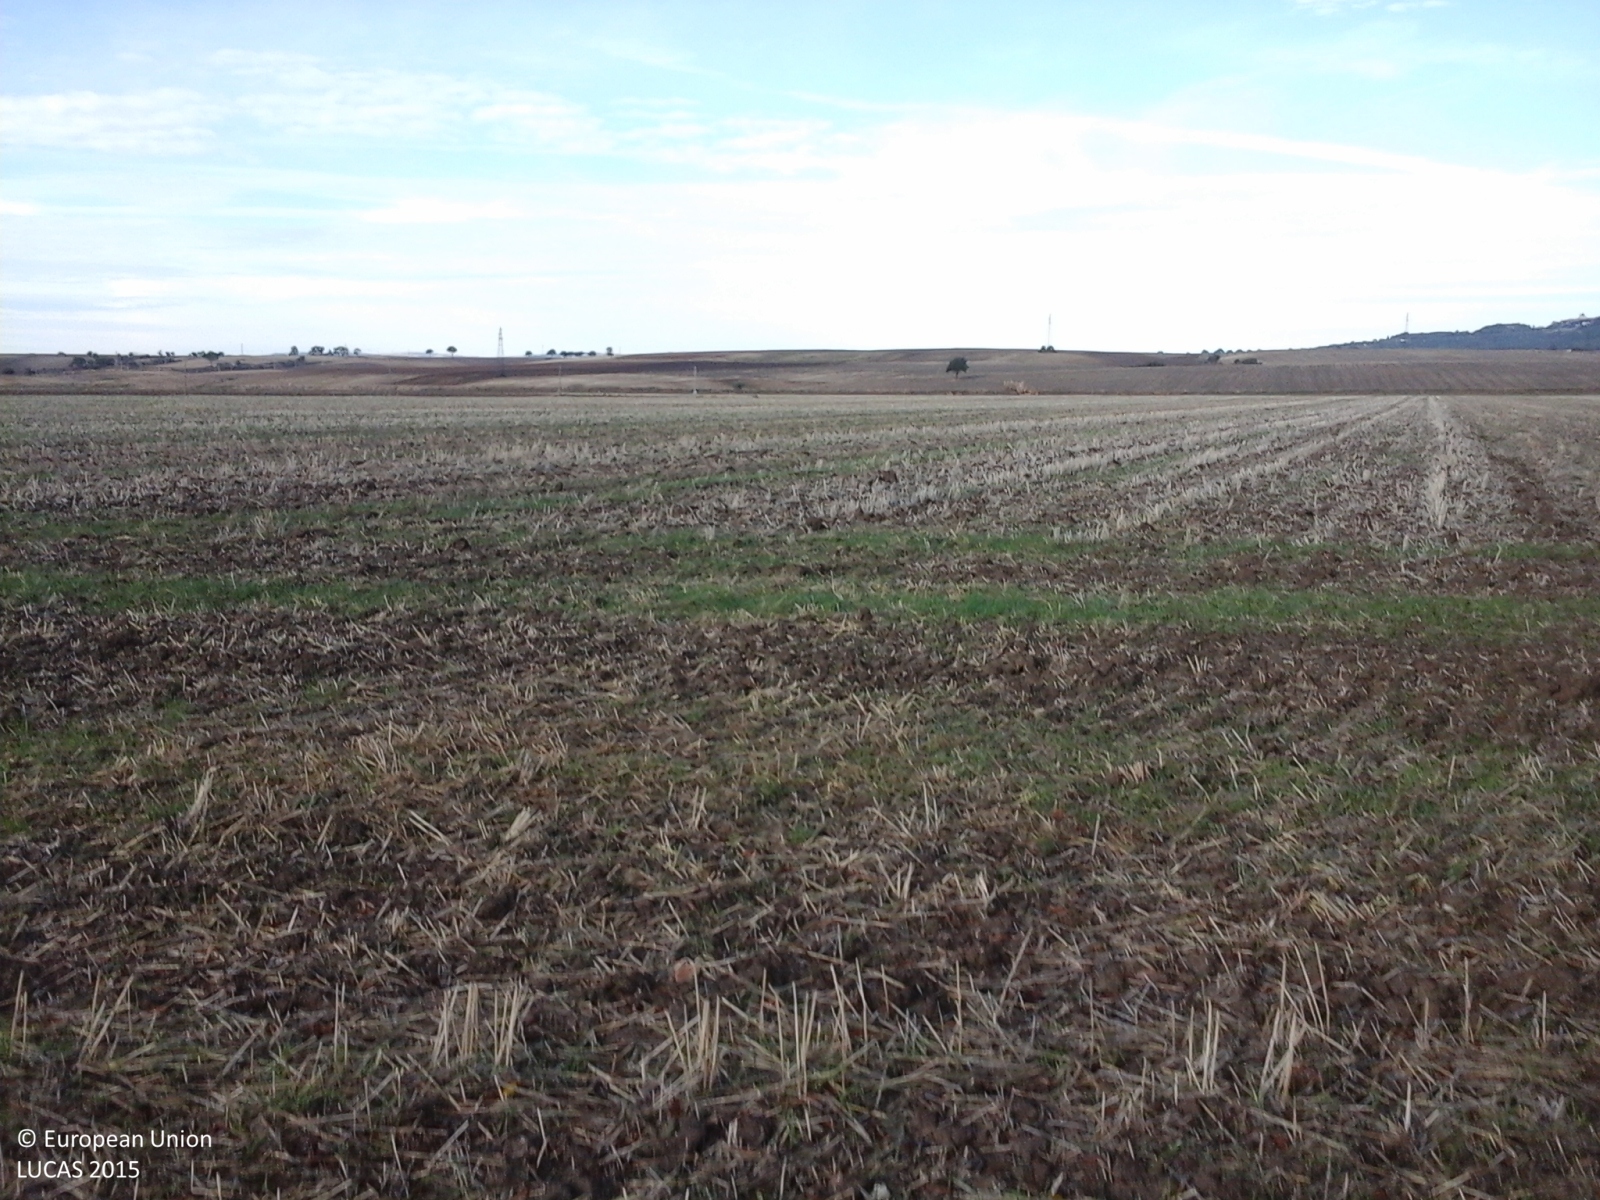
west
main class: Cropland
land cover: Durum wheat
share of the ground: > 75 %
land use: Agriculture (excluding fallow land and kitchen gardens)
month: October
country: IT
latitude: 41.7955
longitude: 15.2187
